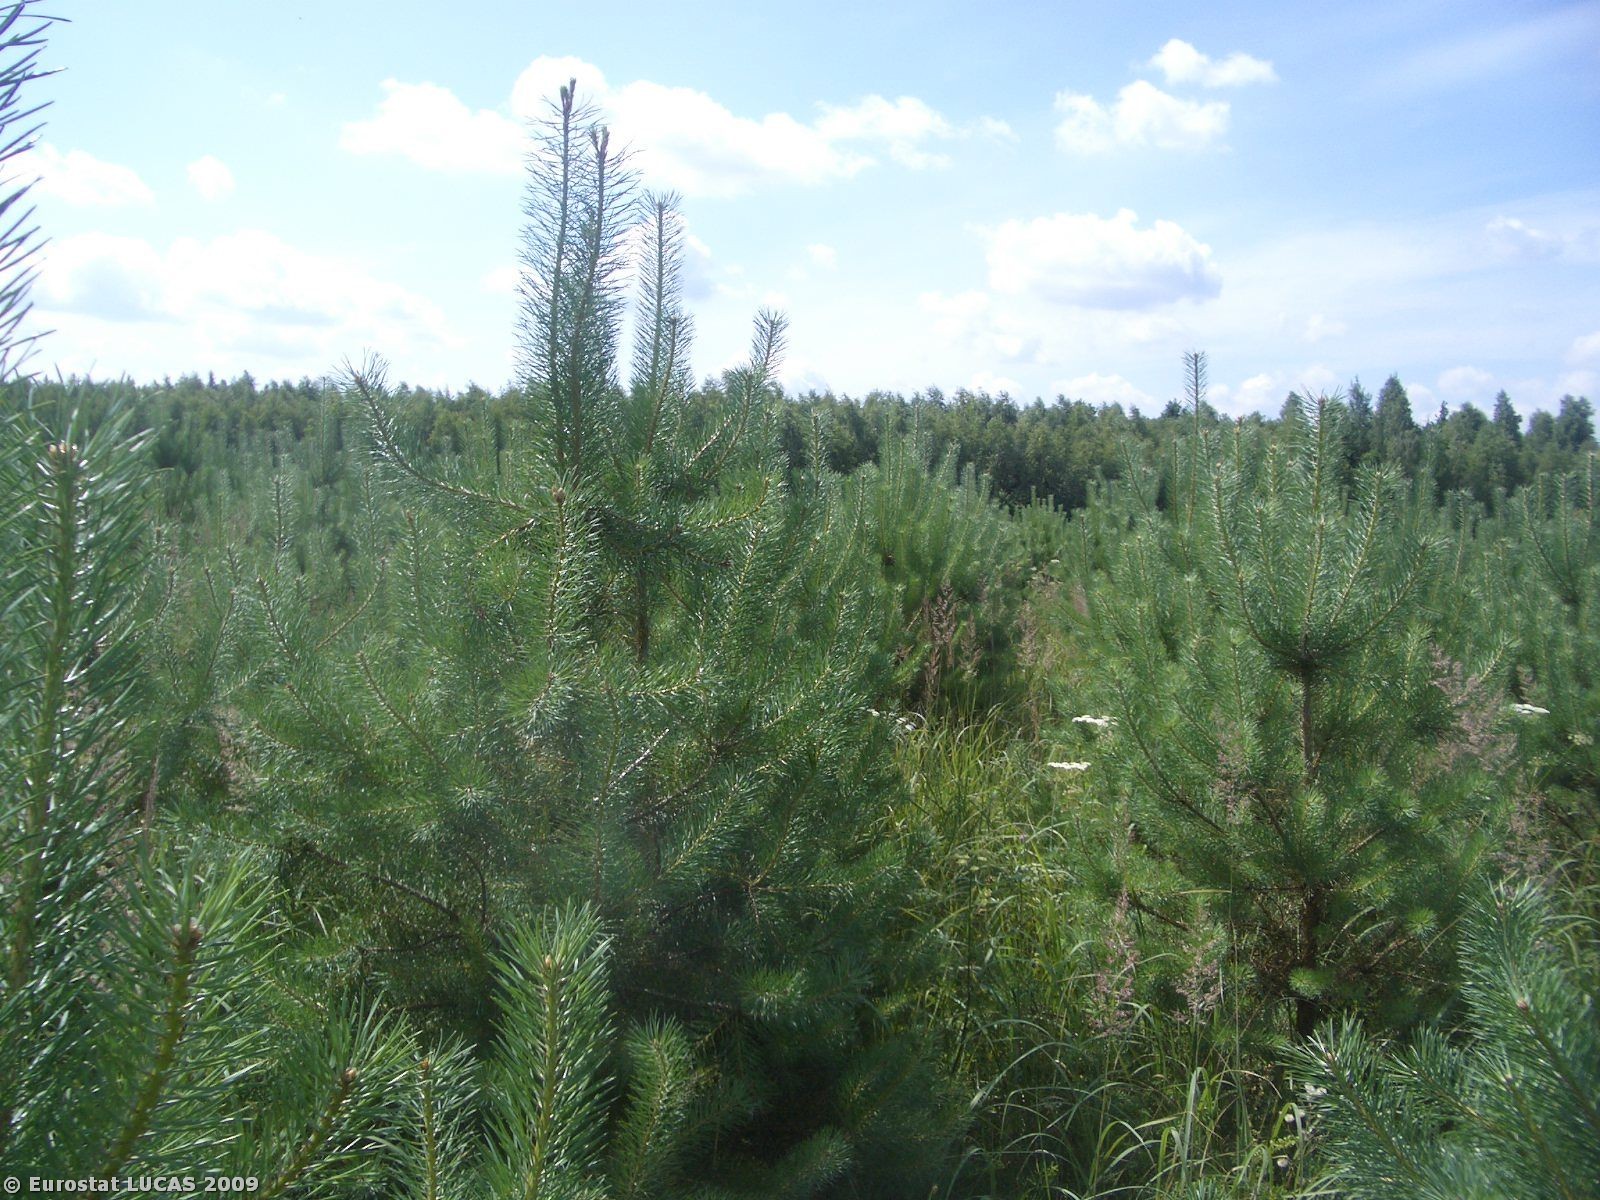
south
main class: Woodland
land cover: Coniferous woodland
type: hemiboreal forest and nemoral coniferous forest and mixed broadleaved-coniferous forest
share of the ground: 50 - 75 %
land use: Forestry
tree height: > 5 m
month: July
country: PL
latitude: 52.3404
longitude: 23.0958
